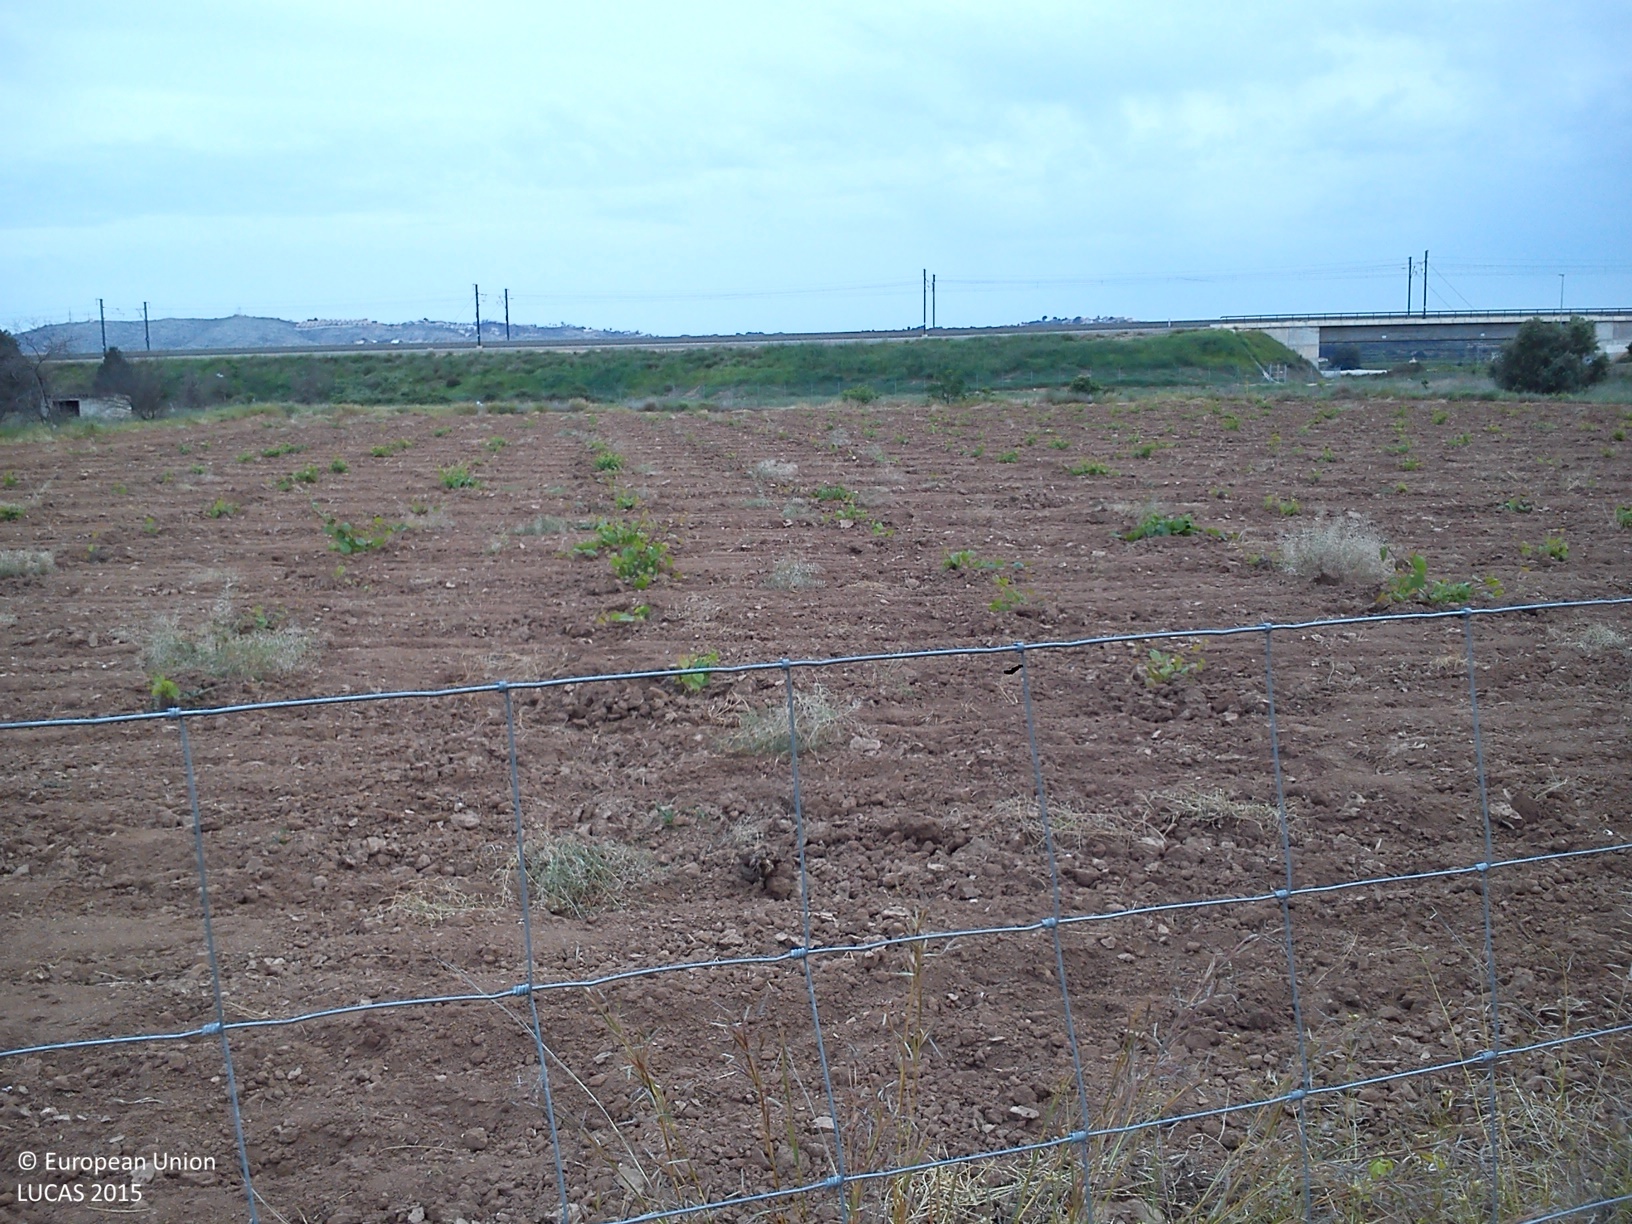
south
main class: Shrubland
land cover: Shrubland without tree cover
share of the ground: > 75 %
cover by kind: herbaceous plants 65 %, shrubs 35 %
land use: Abandoned areas
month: April
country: ES
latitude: 39.4738
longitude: -0.5883
